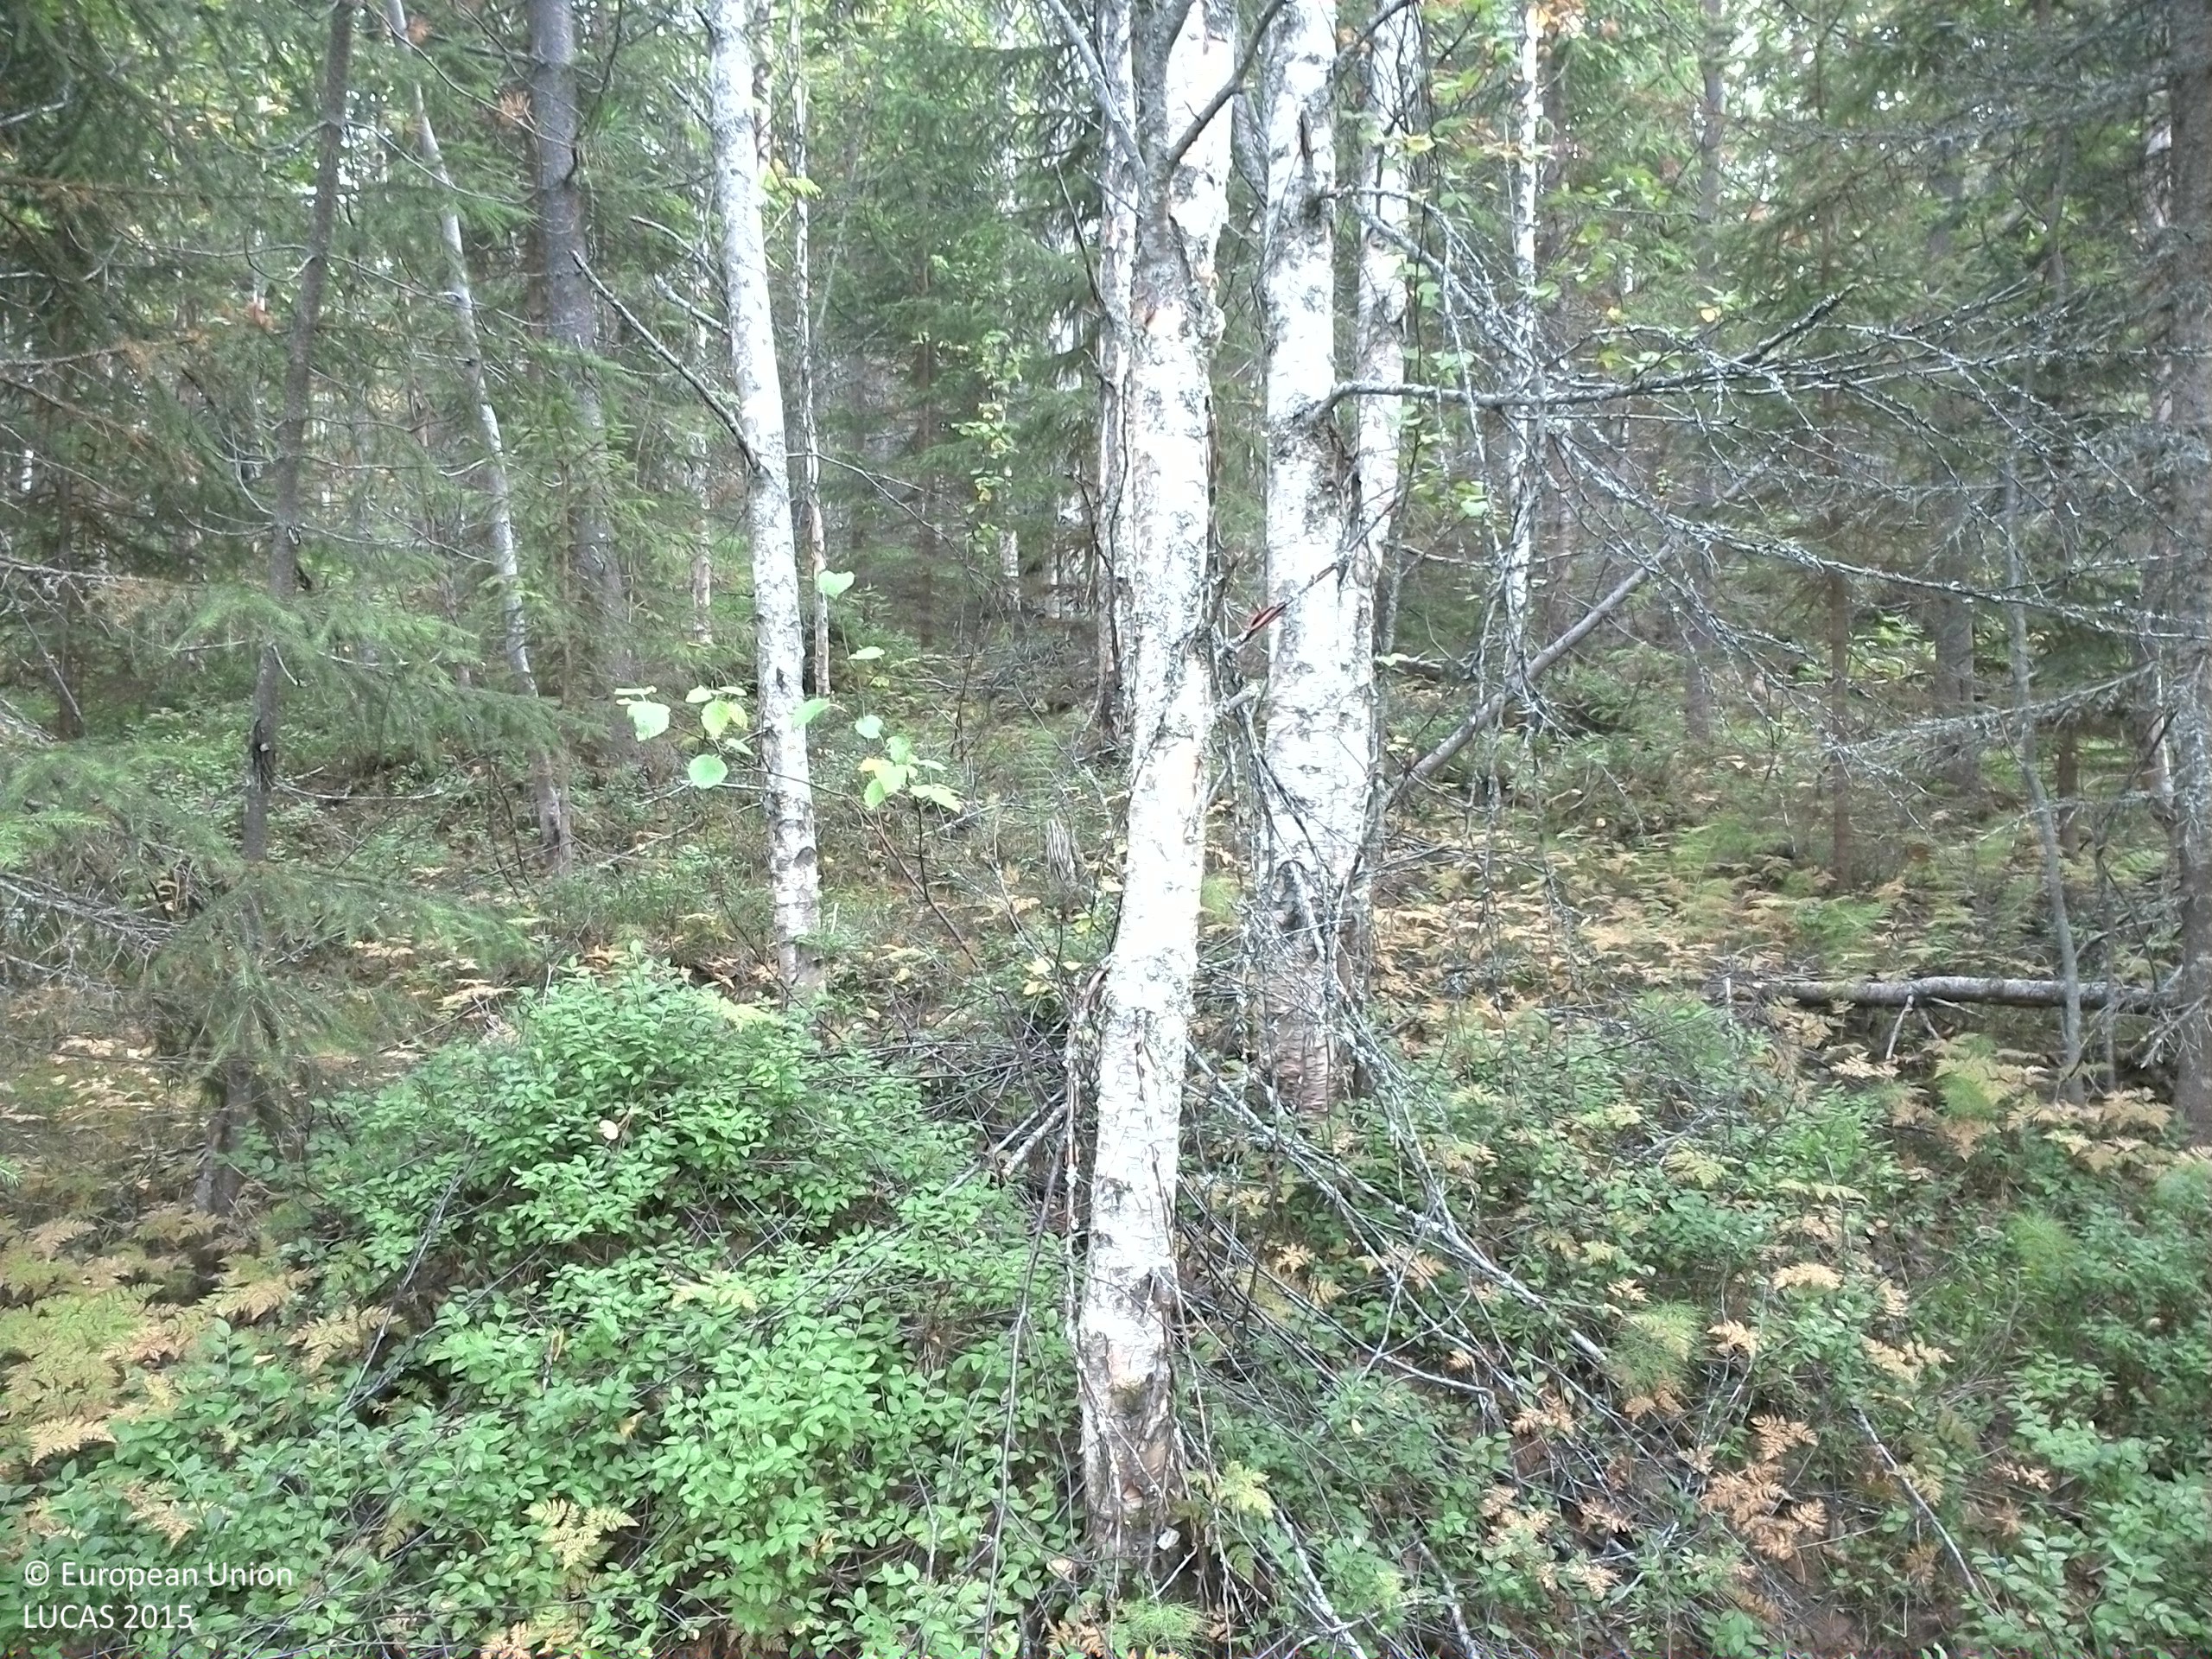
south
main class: Woodland
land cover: Other mixed woodland
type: boreal forest
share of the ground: 50 - 75 %
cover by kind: coniferous forest trees 35 %, broadleaved forest trees 35 %, shrubs 25 %, lichens and mosses 5 %
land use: Forestry
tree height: > 5 m
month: September
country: SE
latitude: 64.0209
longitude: 16.7023
